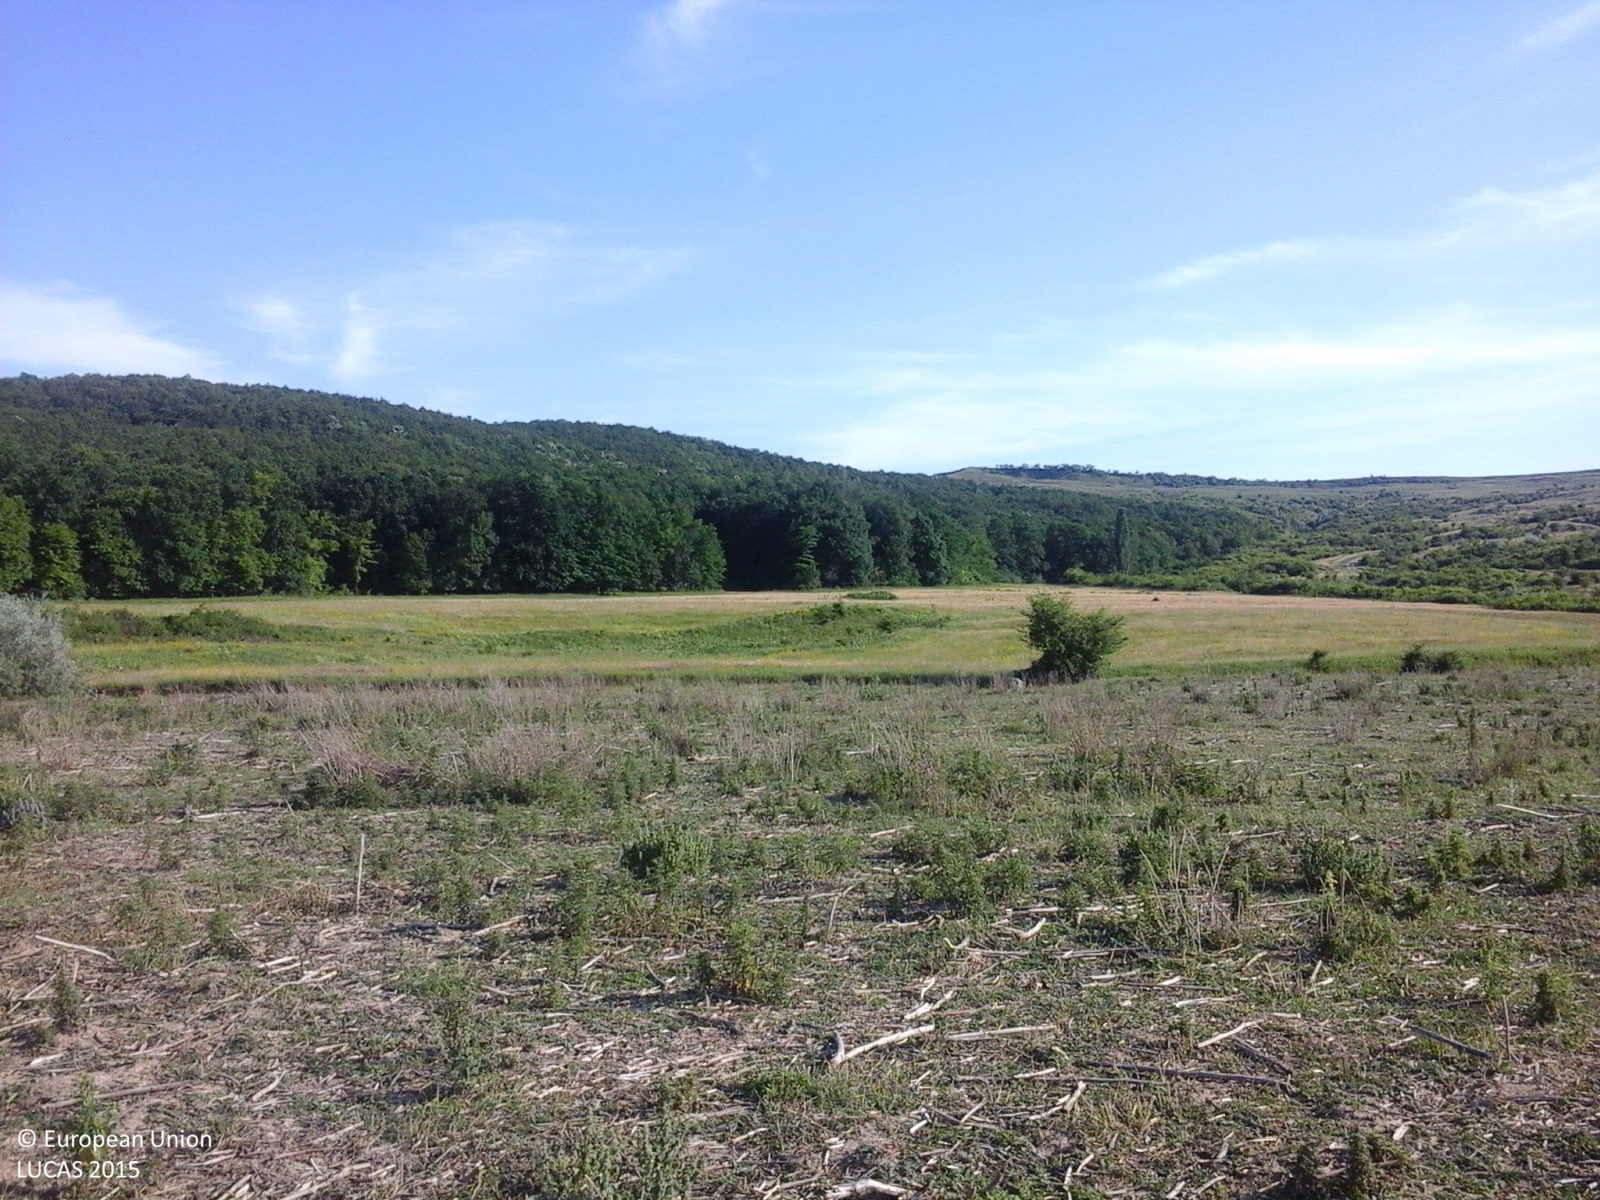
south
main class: Grassland
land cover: Spontaneously vegetated surfaces
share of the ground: > 75 %
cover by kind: herbaceous plants 100 %
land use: Agriculture (excluding fallow land and kitchen gardens)
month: June
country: RO
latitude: 47.1269
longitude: 27.0139
